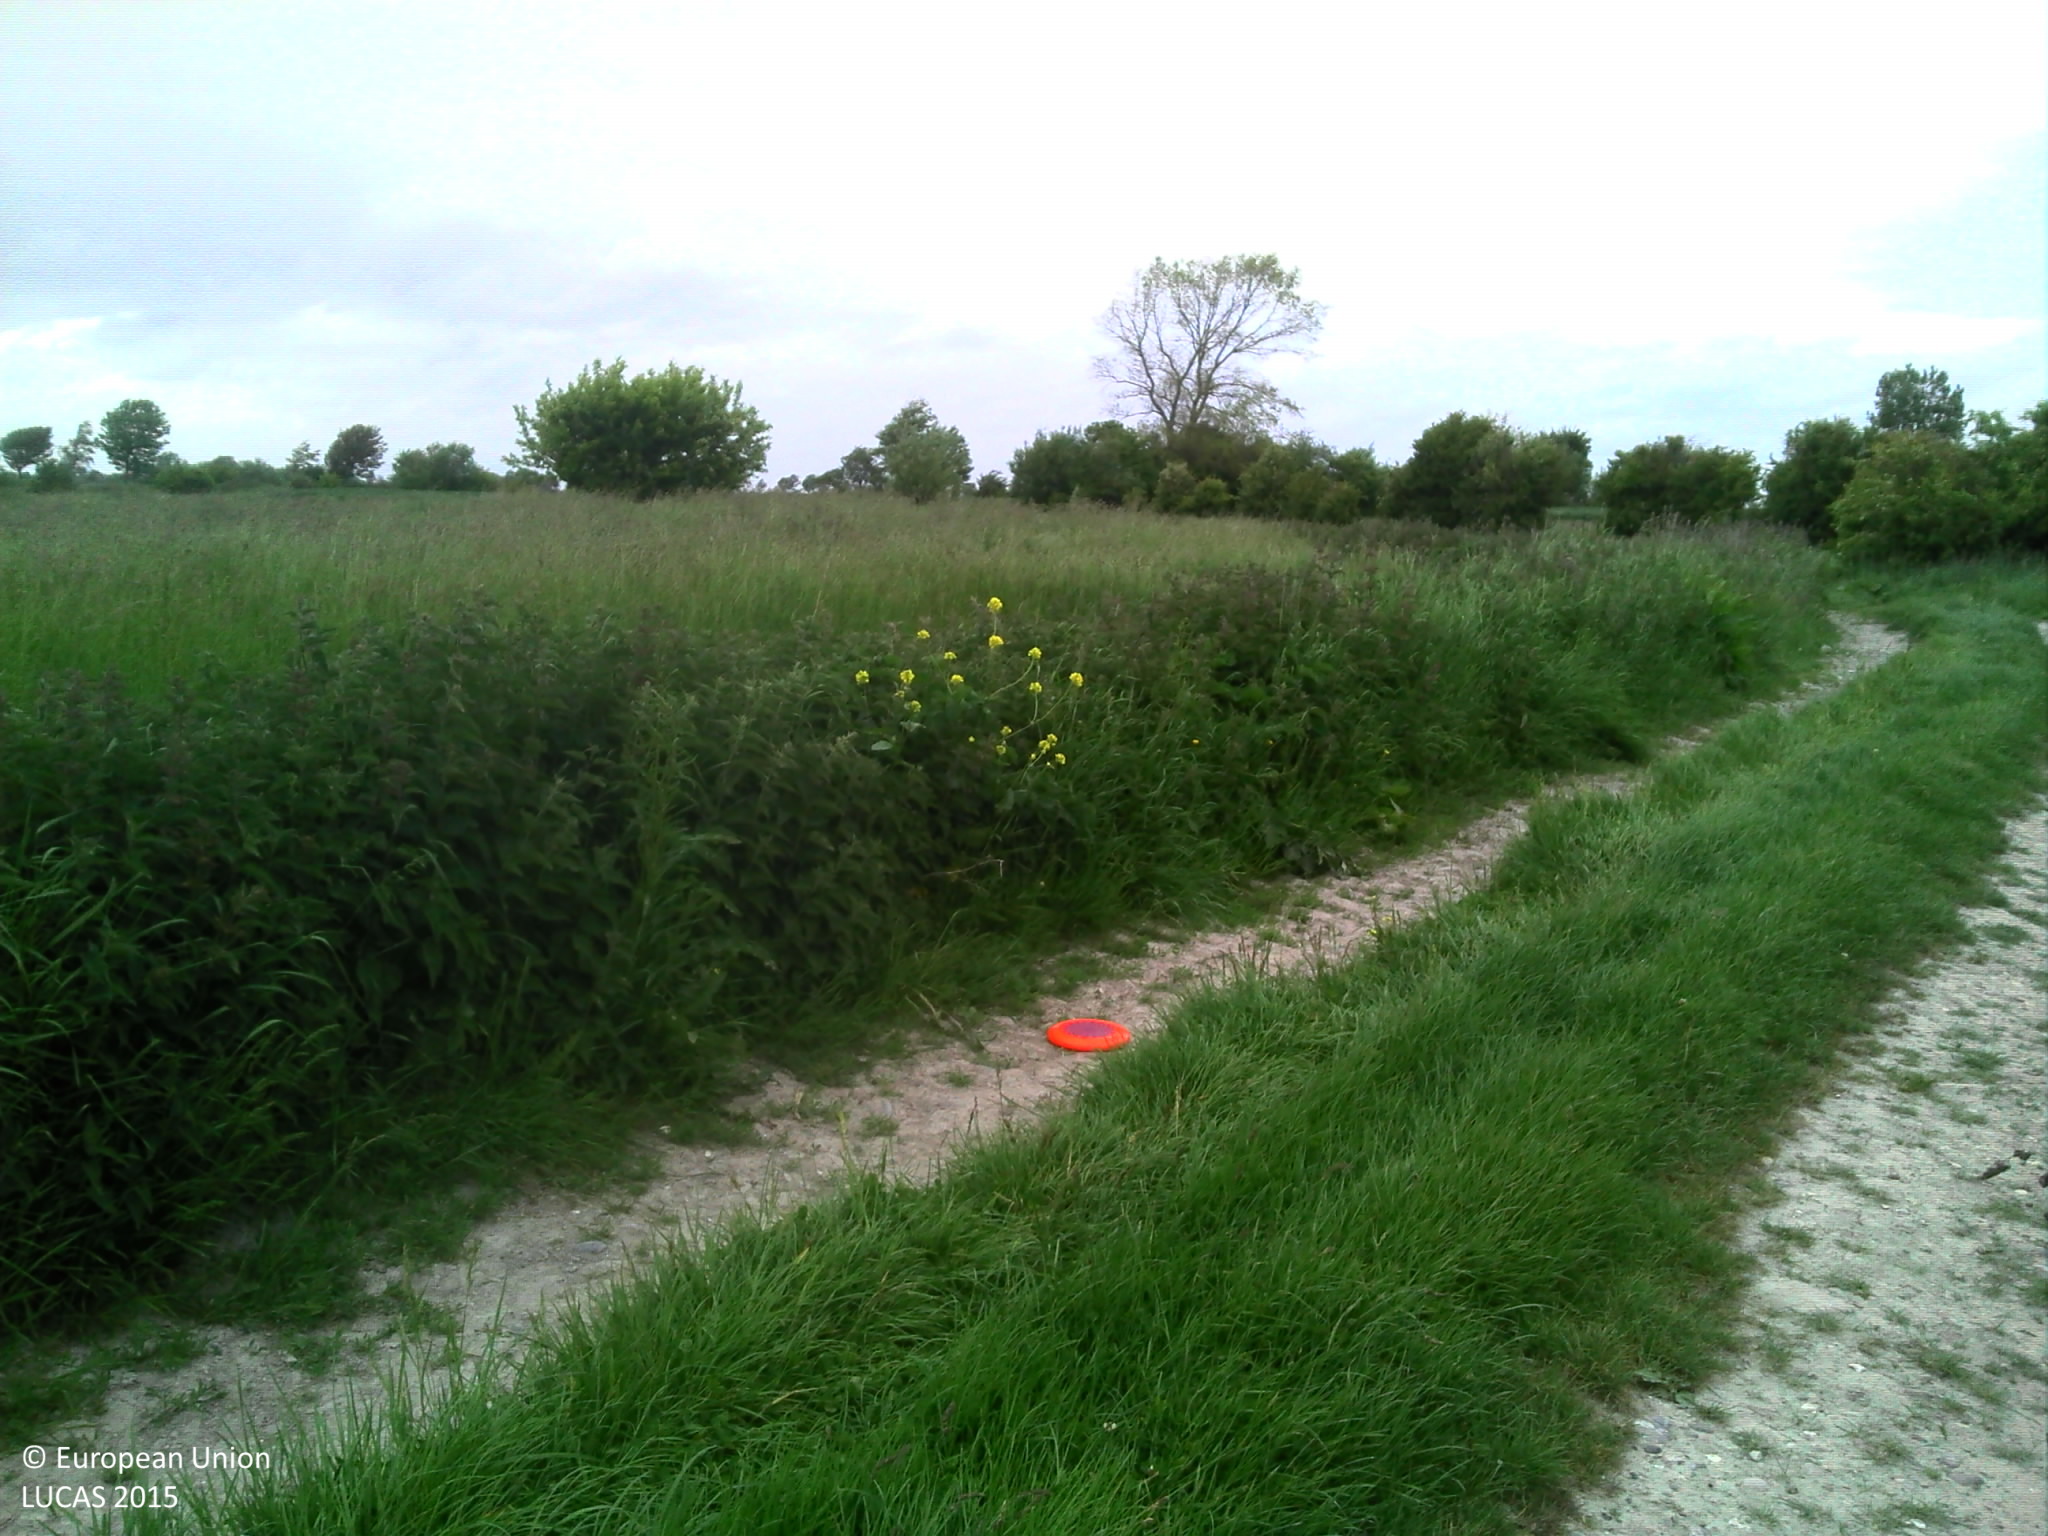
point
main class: Grassland
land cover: Grassland without tree/shrub cover
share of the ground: > 75 %
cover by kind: herbaceous plants 100 %
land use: Agriculture (excluding fallow land and kitchen gardens)
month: May
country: FR
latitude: 50.1787
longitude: 1.5655
